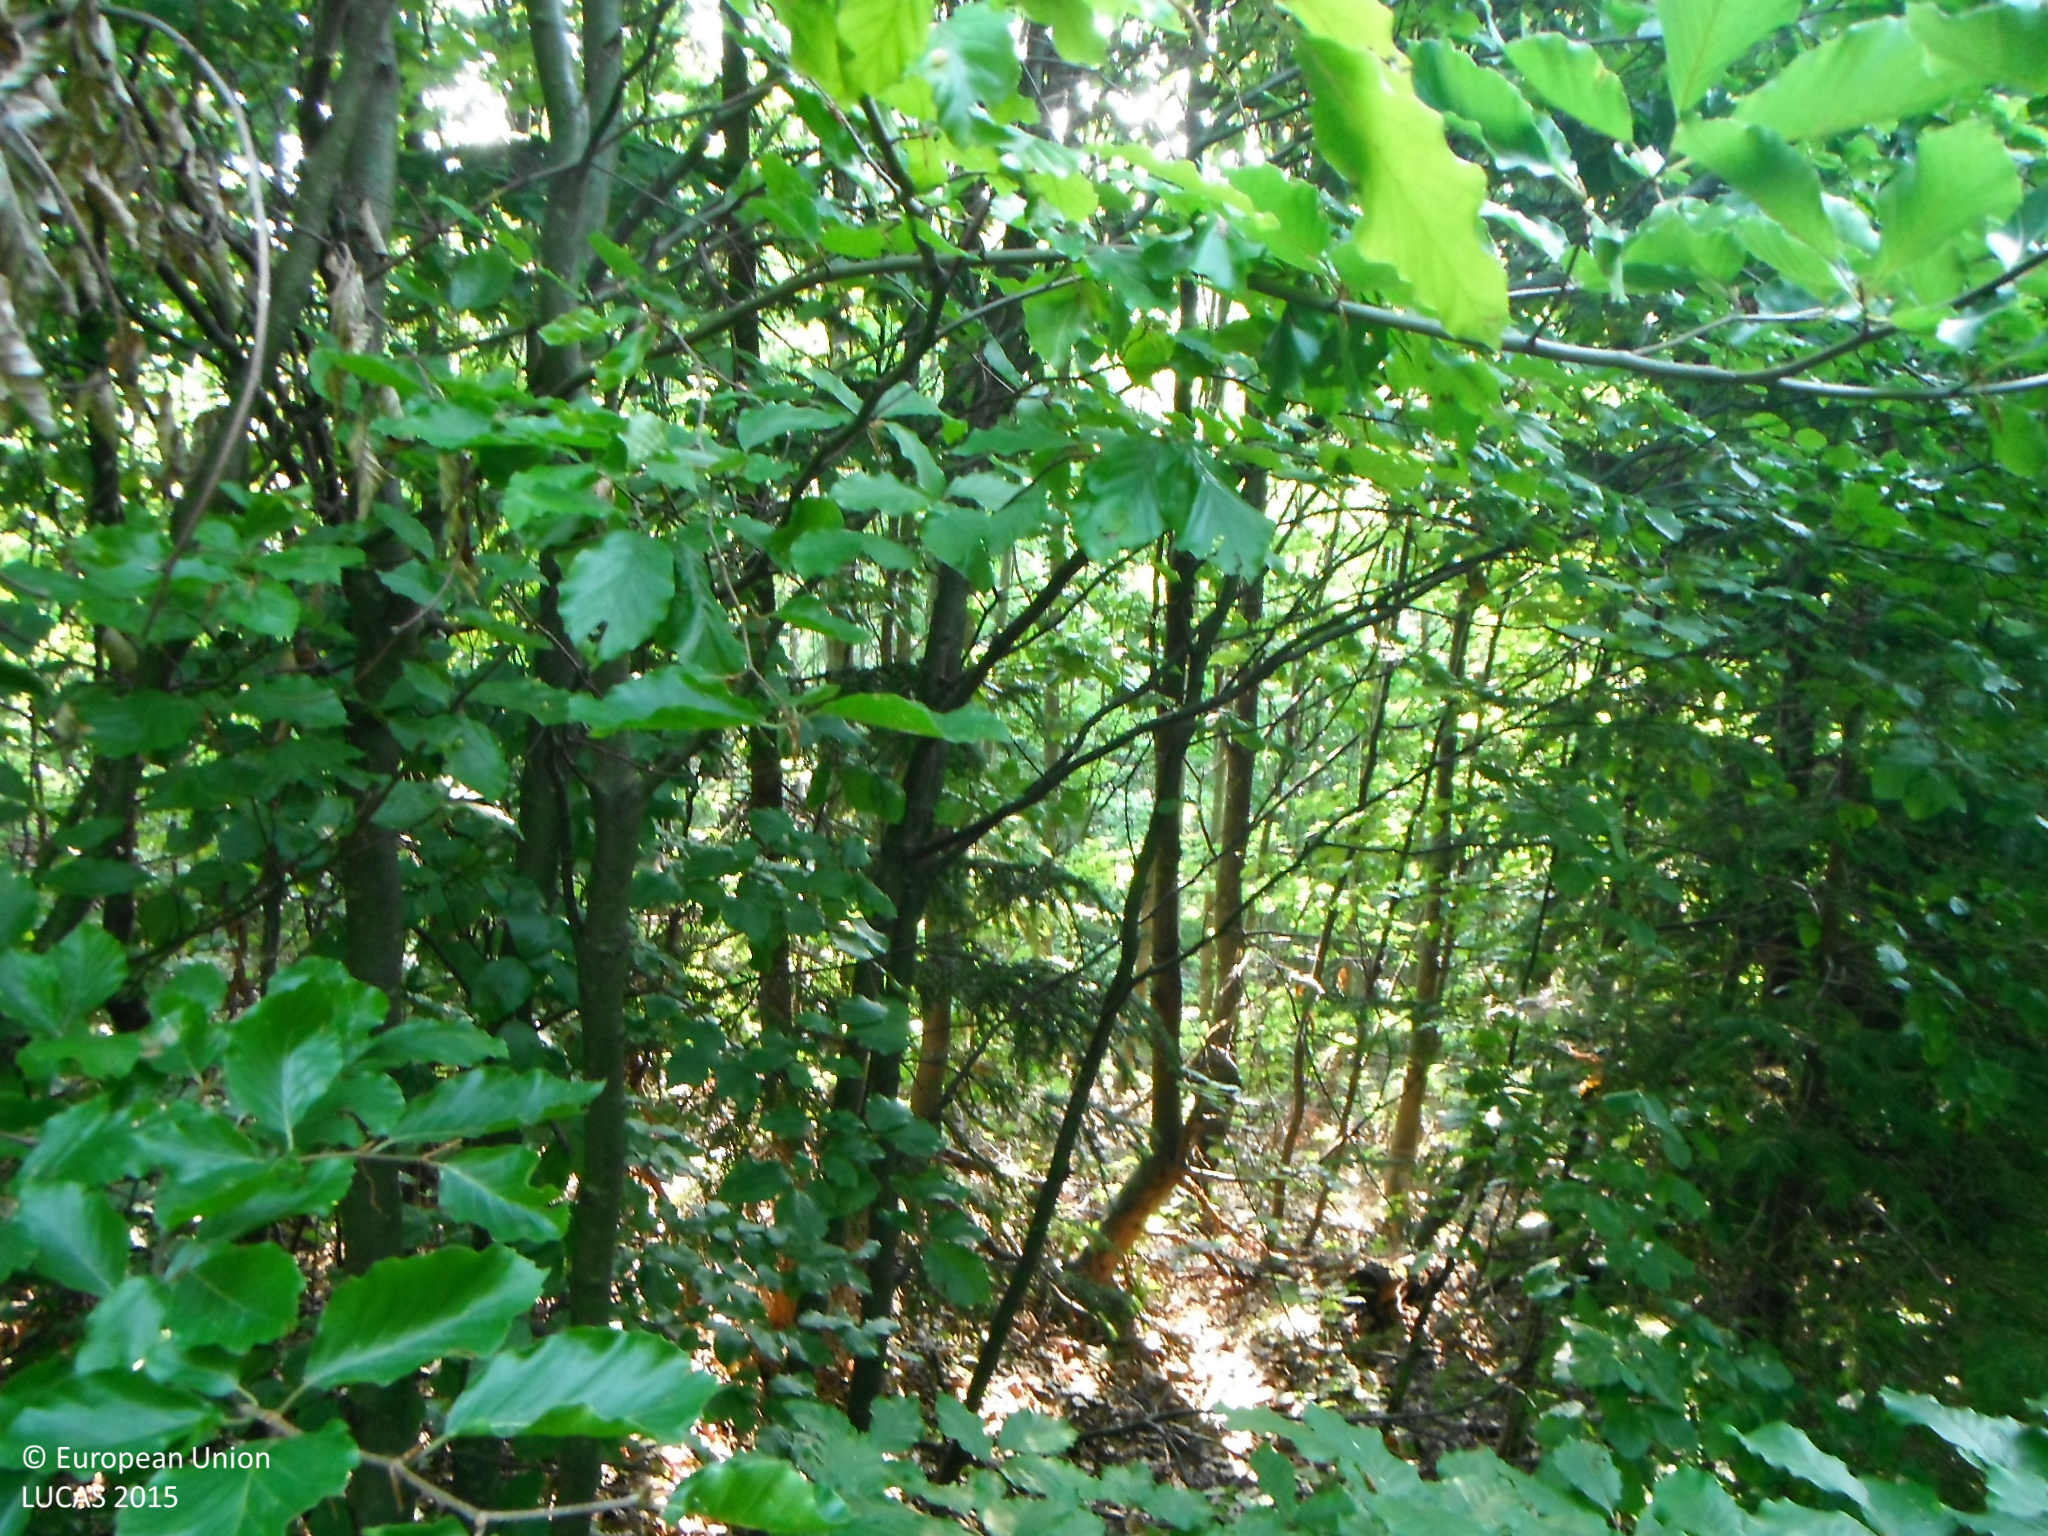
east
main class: Woodland
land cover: Broadleaved woodland
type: mountainous beech forest
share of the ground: > 75 %
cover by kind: broadleaved forest trees 100 %
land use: Forestry
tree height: > 5 m
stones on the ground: < 10 %
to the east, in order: Broadleaved woodland; Spruce dominated coniferous woodland; Ditches and canals; Tracks; Shruby margins; Spruce dominated coniferous woodland; Spruce dominated mixed woodland; Spruce dominated coniferous woodland; Tracks; Spruce dominated mixed woodland
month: August
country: SK
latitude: 48.8481
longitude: 19.0293
